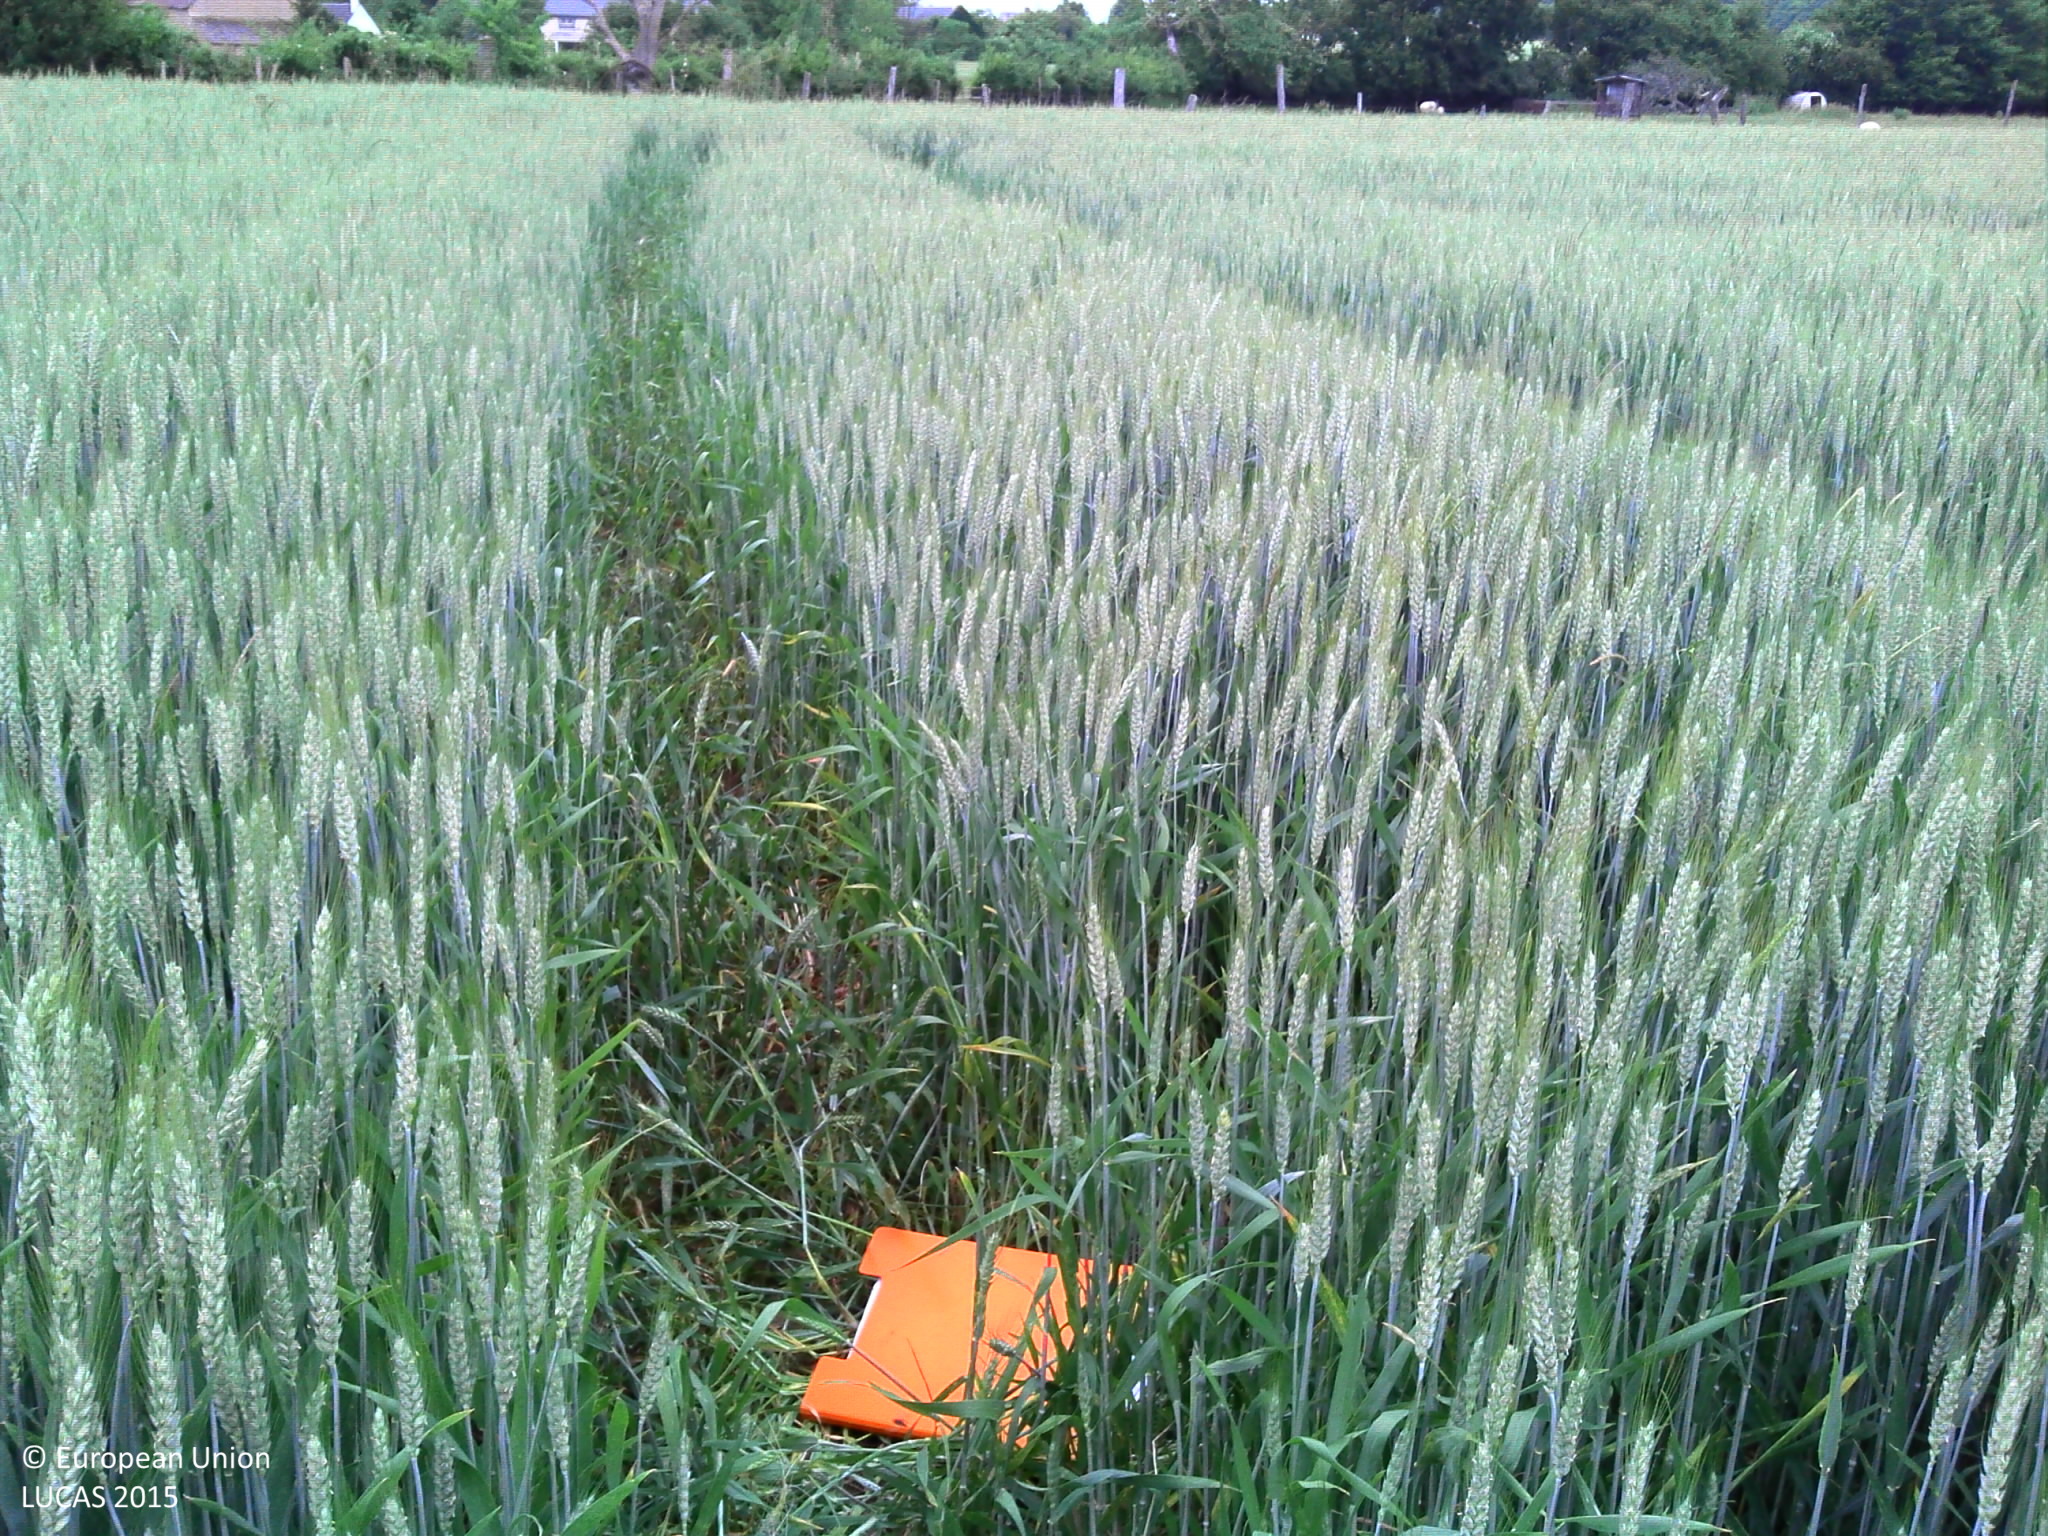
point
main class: Cropland
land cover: Common wheat
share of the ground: > 75 %
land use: Agriculture (excluding fallow land and kitchen gardens)
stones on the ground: < 10 %
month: May
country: FR
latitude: 47.1144
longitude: 2.7060
